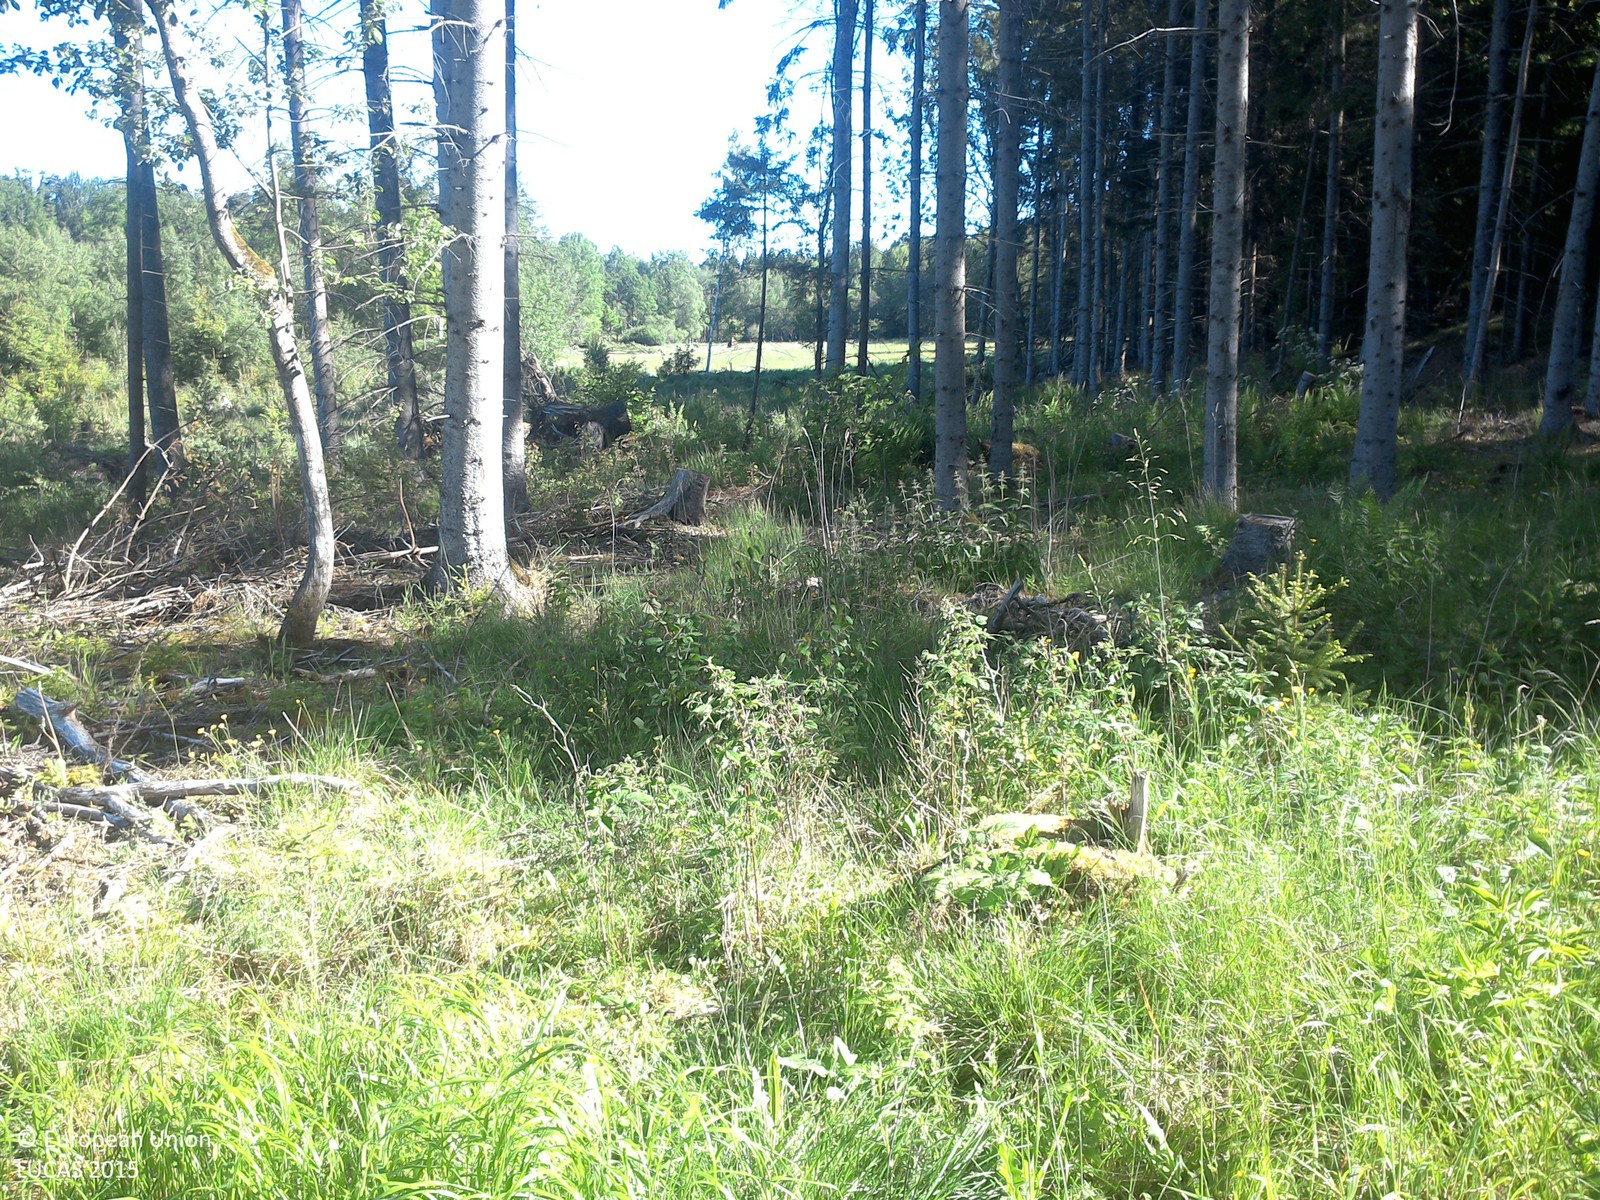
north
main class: Woodland
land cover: Spruce dominated coniferous woodland
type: boreal forest
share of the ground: 50 - 75 %
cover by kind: coniferous forest trees 65 %, lichens and mosses 30 %, broadleaved forest trees 5 %
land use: Forestry
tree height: > 5 m
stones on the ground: < 10 %
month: June
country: SE
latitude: 58.3160
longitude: 15.6792
